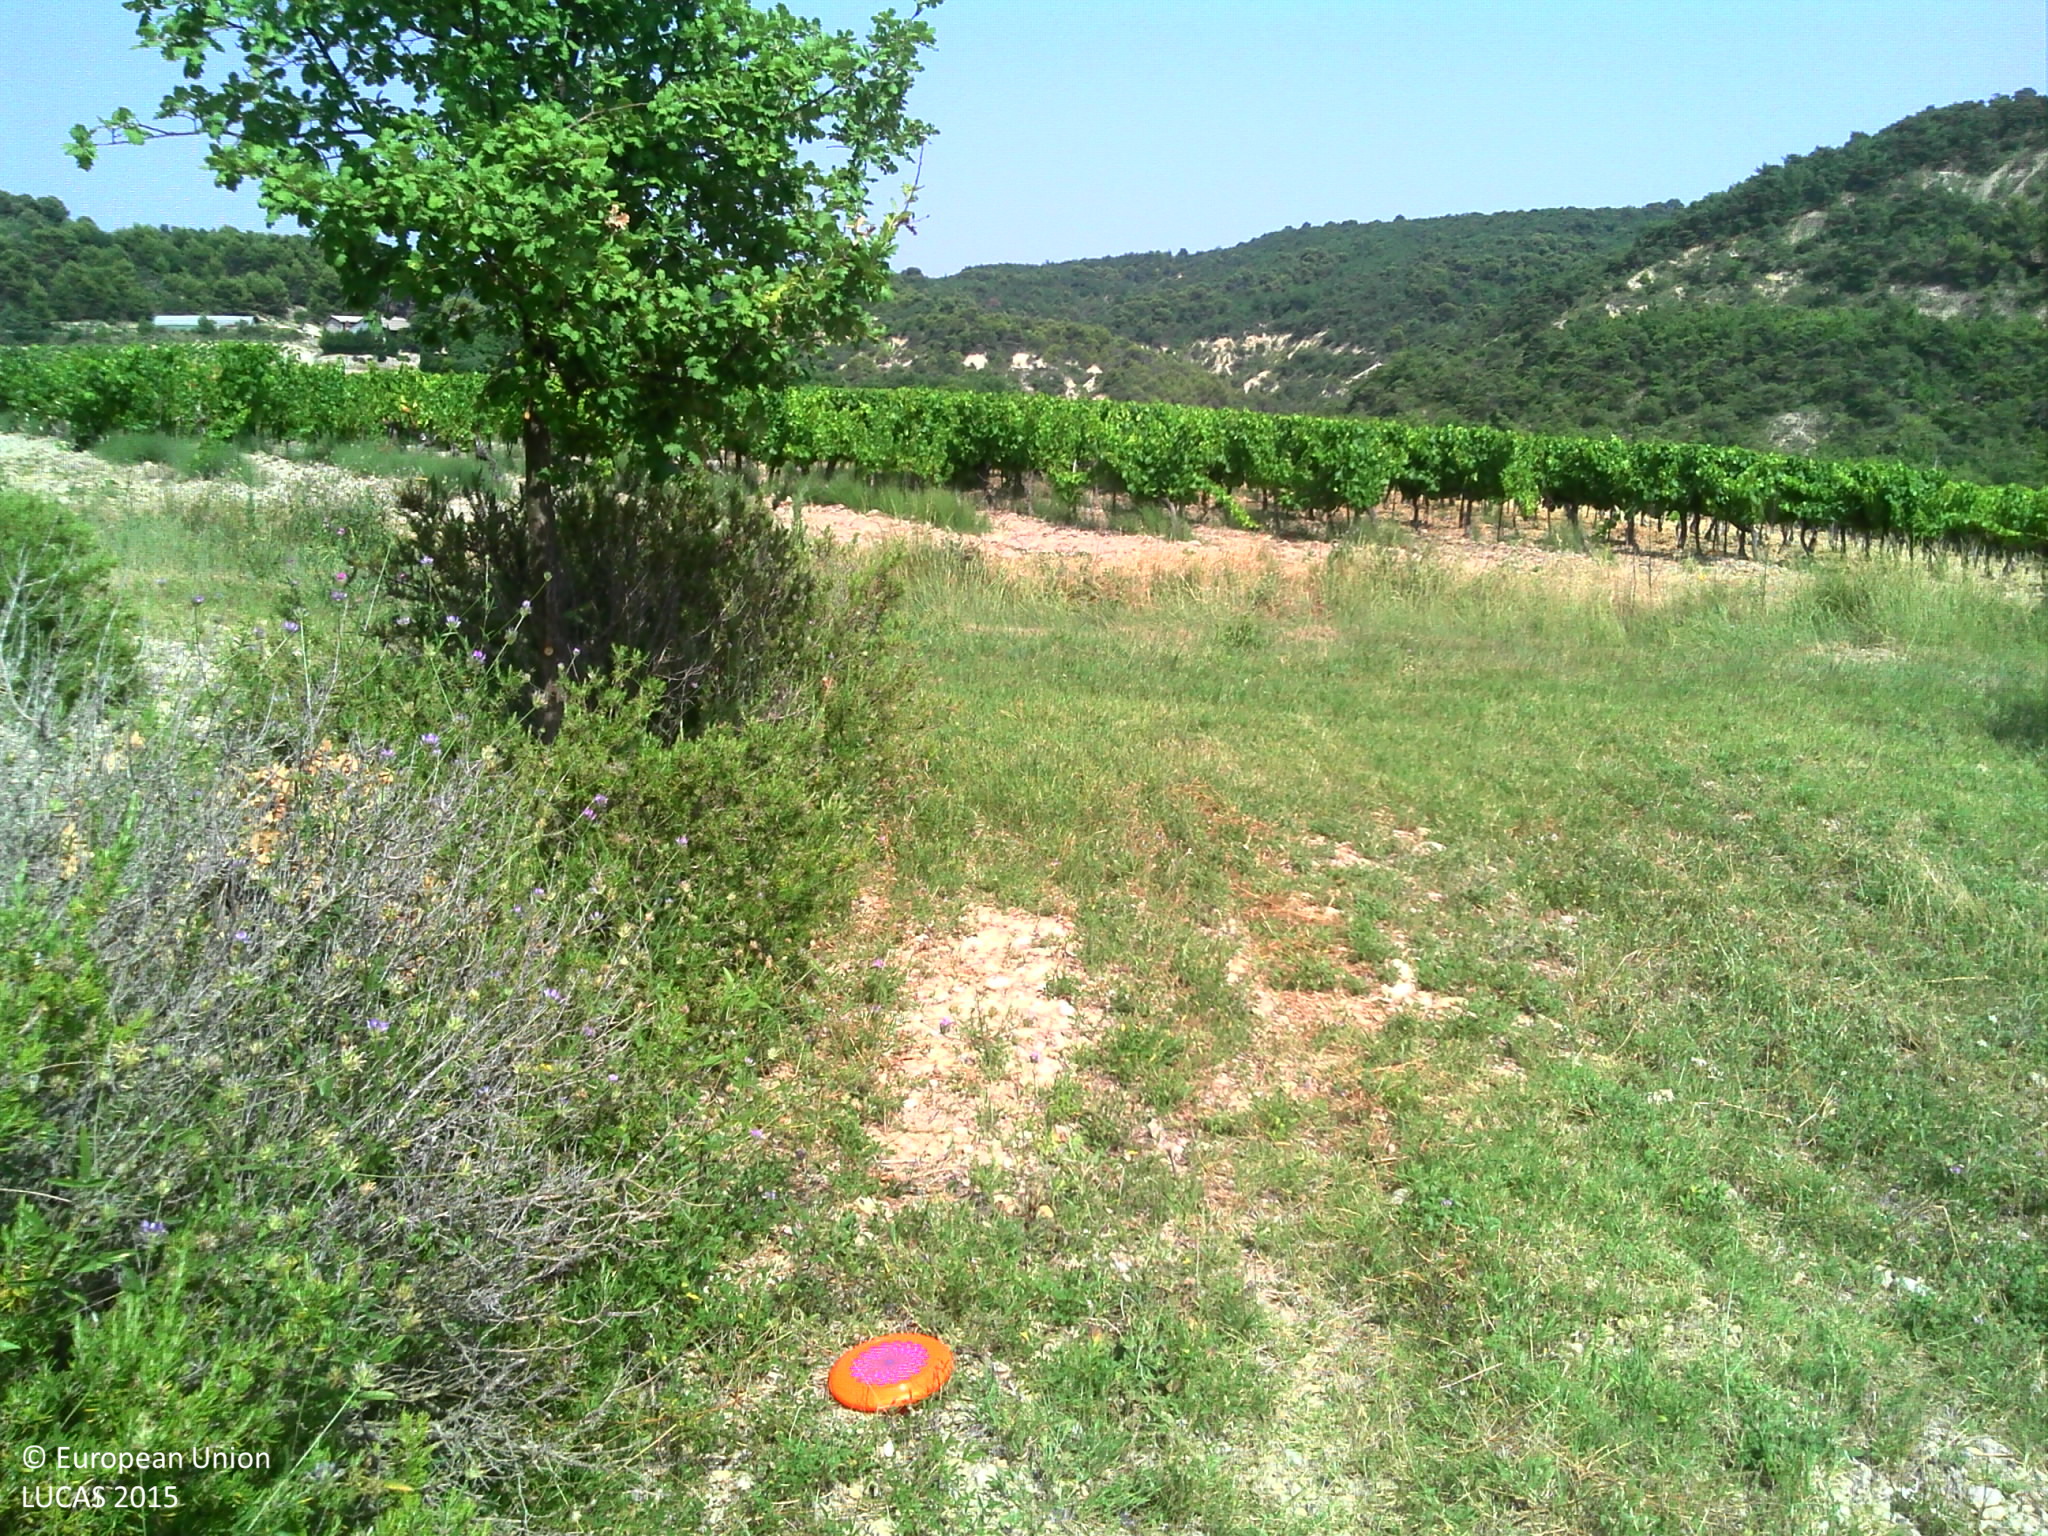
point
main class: Cropland
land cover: Other fresh vegetables
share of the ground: 25 - 50 %
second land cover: Spontaneously vegetated surfaces
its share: 50 - 75 %
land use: Agriculture (excluding fallow land and kitchen gardens)
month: July
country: FR
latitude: 44.3770
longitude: 5.0498
